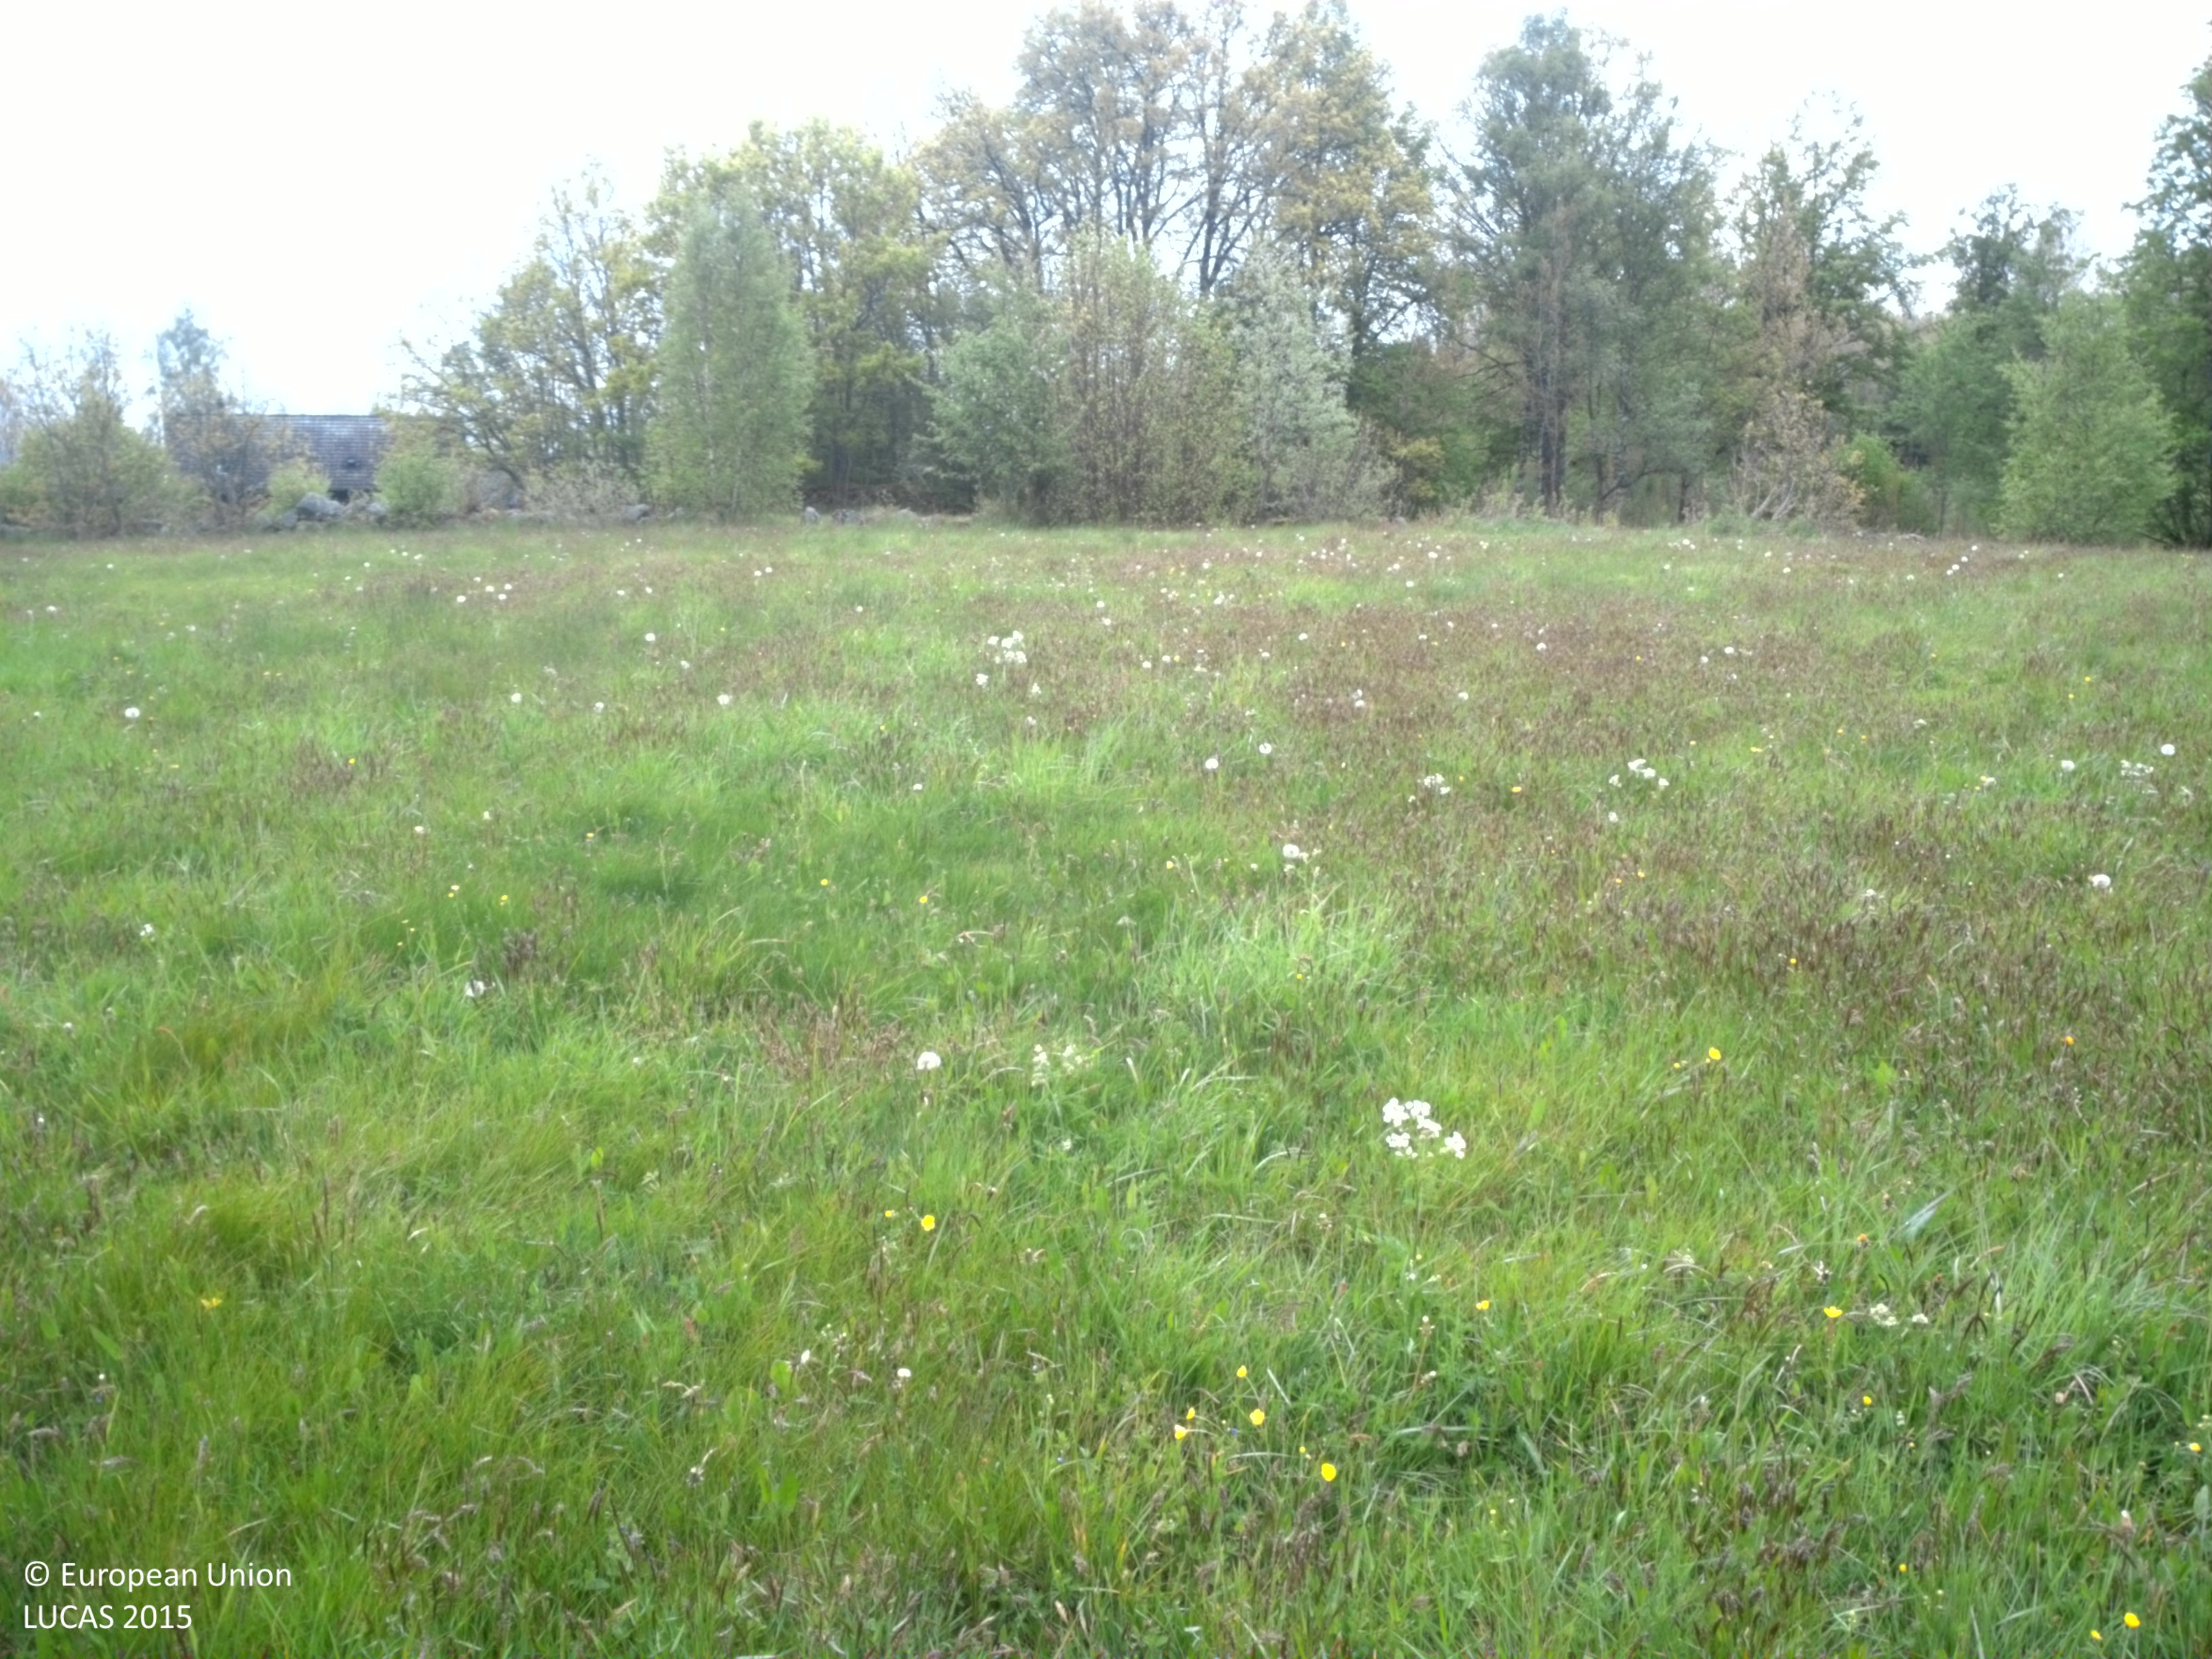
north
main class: Grassland
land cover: Grassland without tree/shrub cover
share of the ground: > 75 %
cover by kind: herbaceous plants 100 %
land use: Agriculture (excluding fallow land and kitchen gardens)
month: May
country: SE
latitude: 56.5706
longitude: 15.1576
